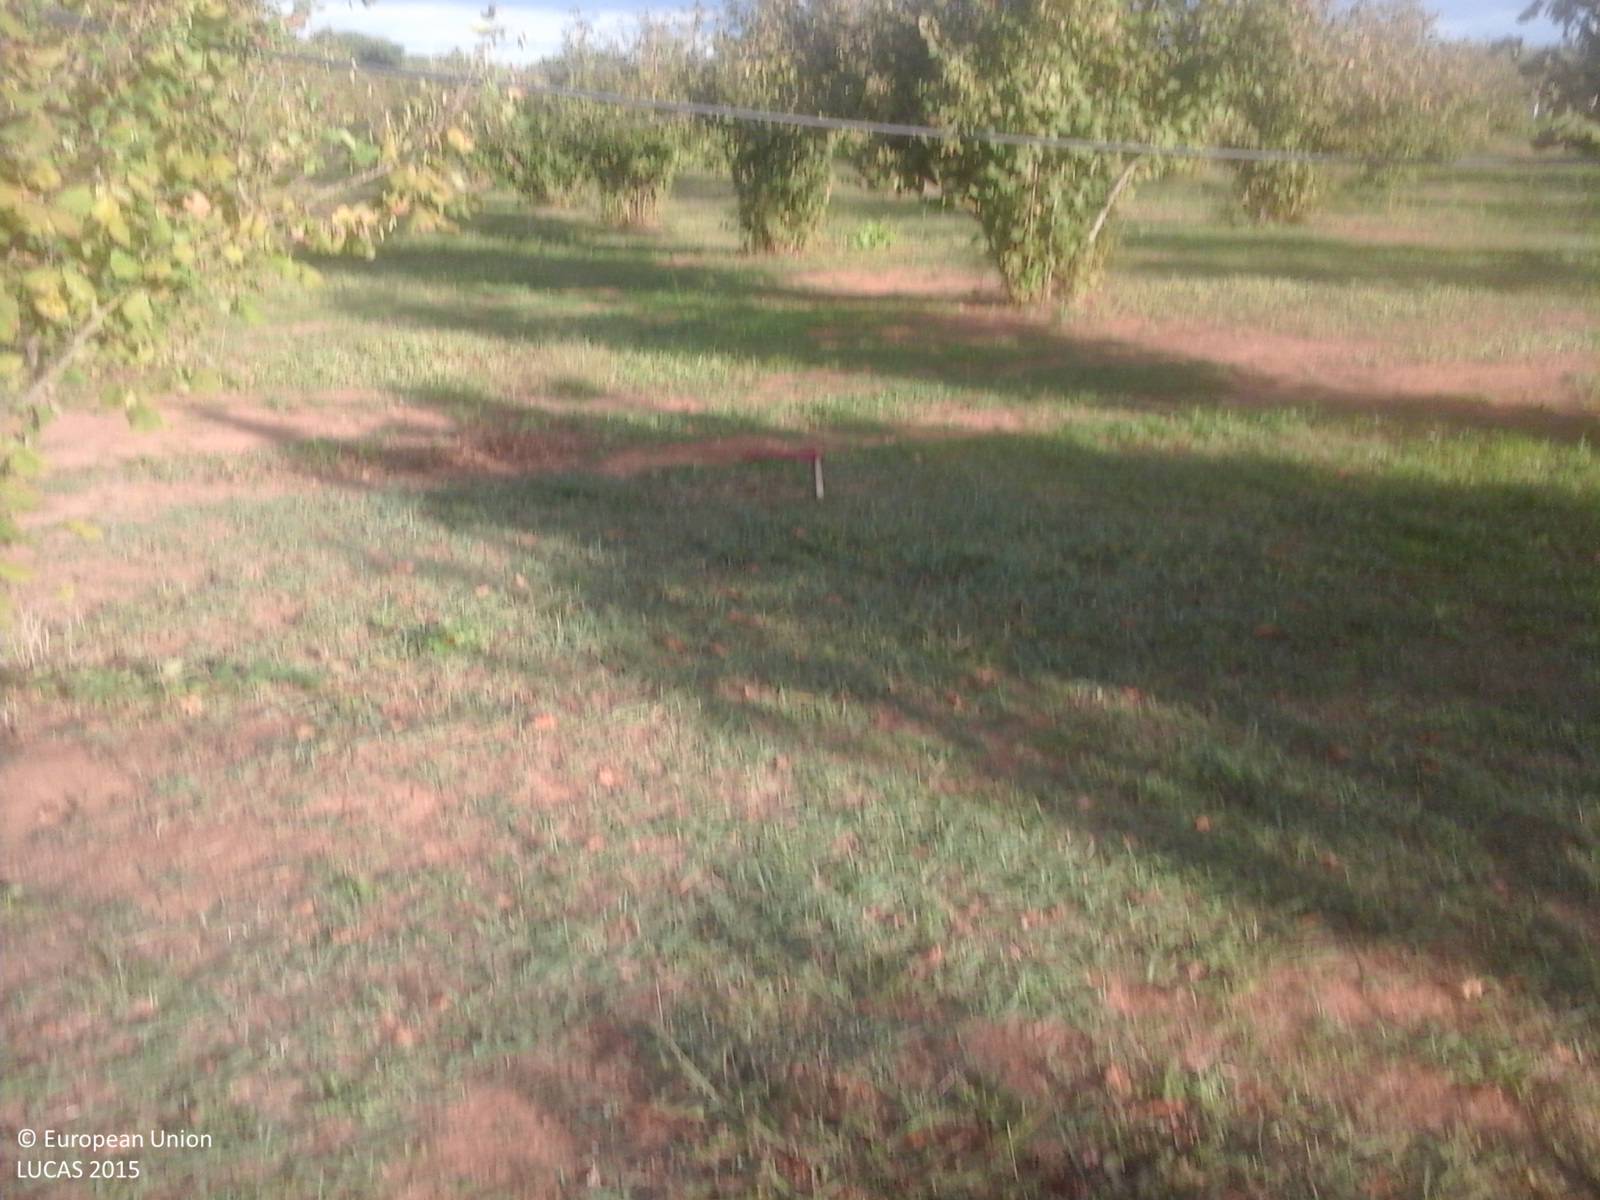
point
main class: Cropland
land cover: Nuts trees
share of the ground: > 75 %
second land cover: Spontaneously vegetated surfaces
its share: > 75 %
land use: Agriculture (excluding fallow land and kitchen gardens)
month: September
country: IT
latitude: 42.4102
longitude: 12.3373
